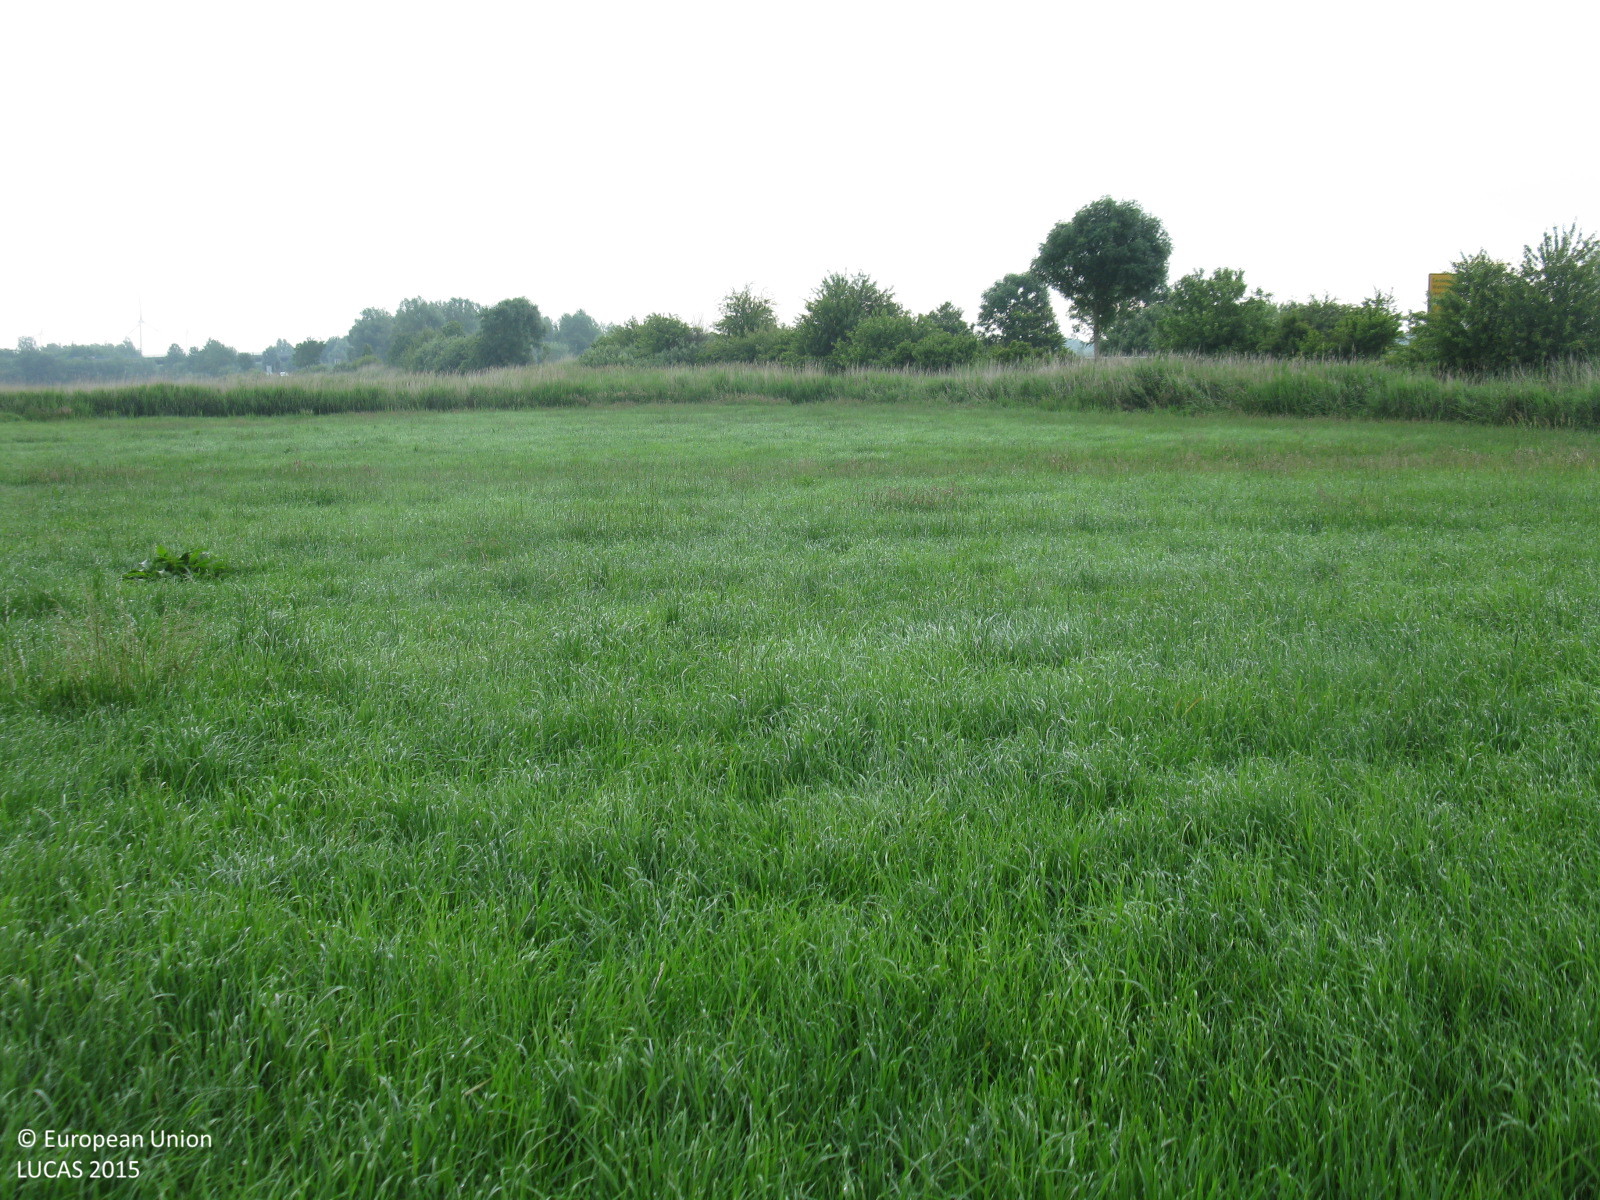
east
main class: Grassland
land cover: Grassland without tree/shrub cover
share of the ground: > 75 %
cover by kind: herbaceous plants 100 %
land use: Agriculture (excluding fallow land and kitchen gardens)
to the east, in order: Grassland without tree/shrub cover; Inland marshes; Ditches and canals; Inland marshes; Ditches and canals; Broadleaved woodland; Paved roads, cycling and walking lanes; Grass margins; Broadleaved woodland; Ditches and canals; Shruby margins; Fences; Grassland without tree/shrub cover
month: June
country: DE
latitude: 53.5810
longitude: 7.8710
